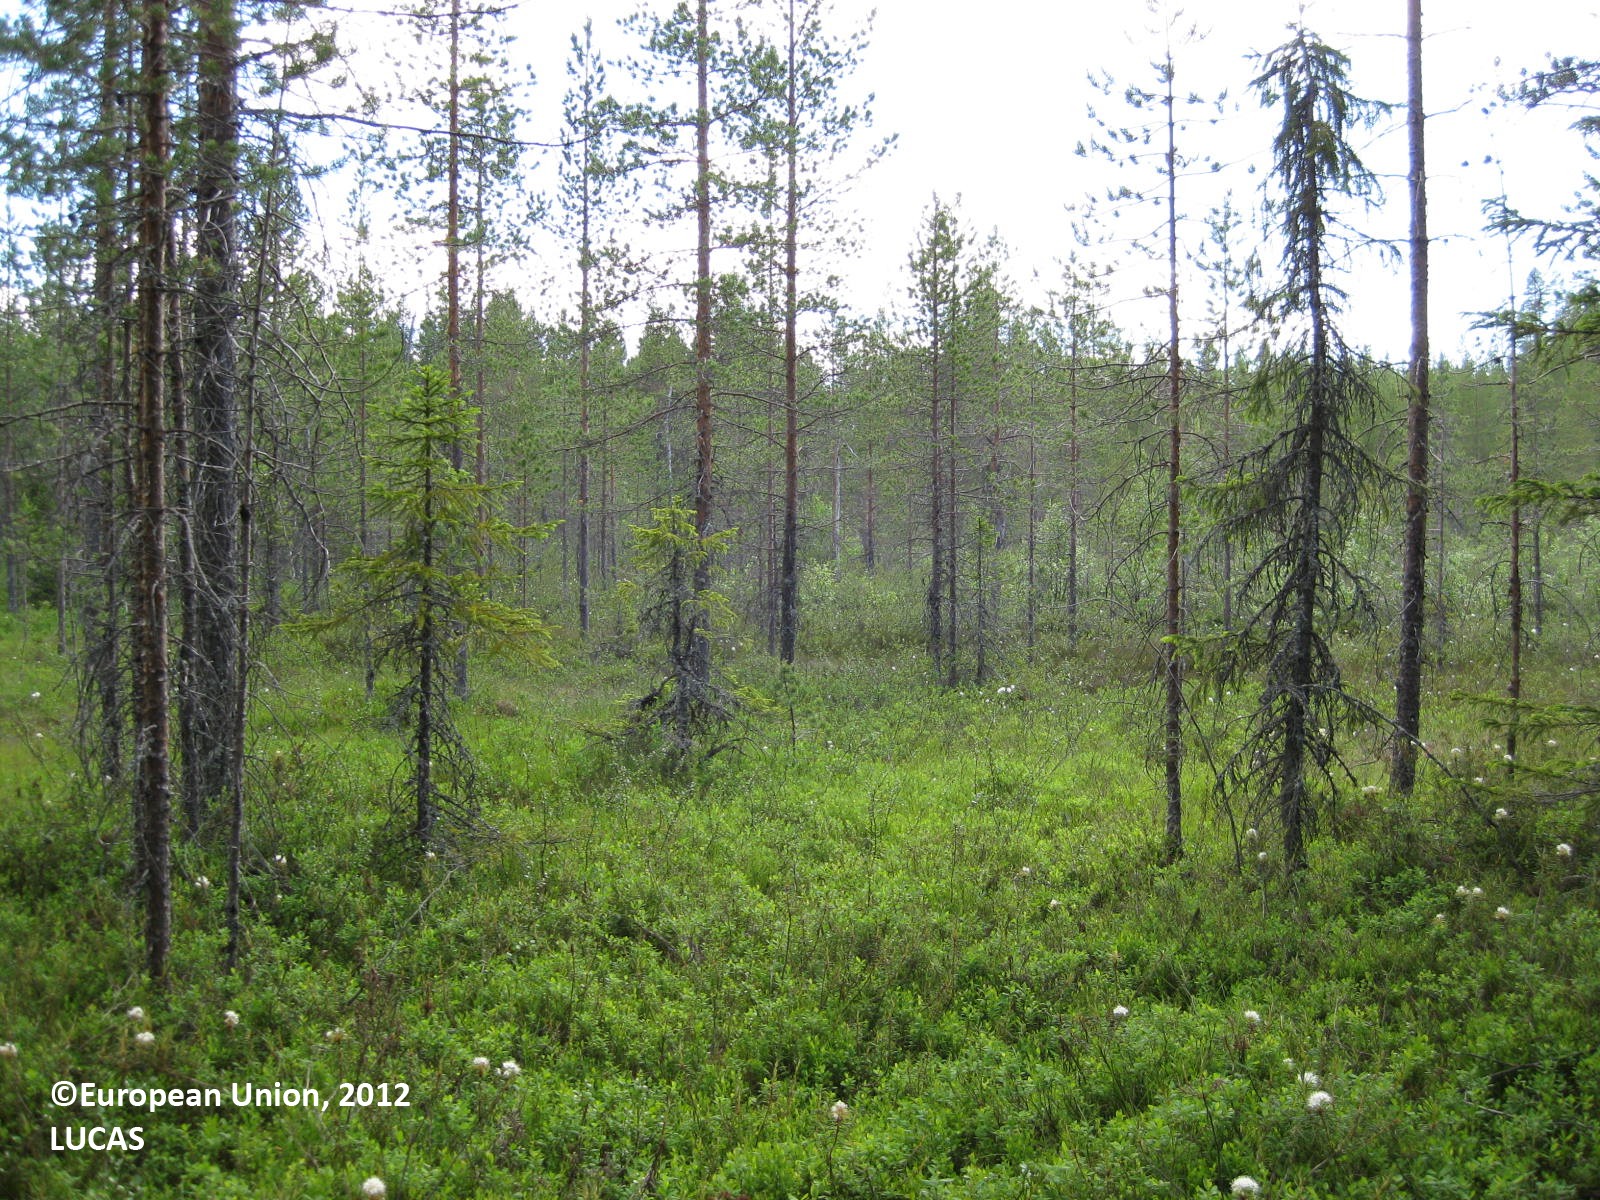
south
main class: Woodland
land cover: Pine dominated coniferous woodland
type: boreal forest
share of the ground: 50 - 75 %
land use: Forestry
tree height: > 5 m
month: July
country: FI
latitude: 65.4608
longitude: 29.1535
